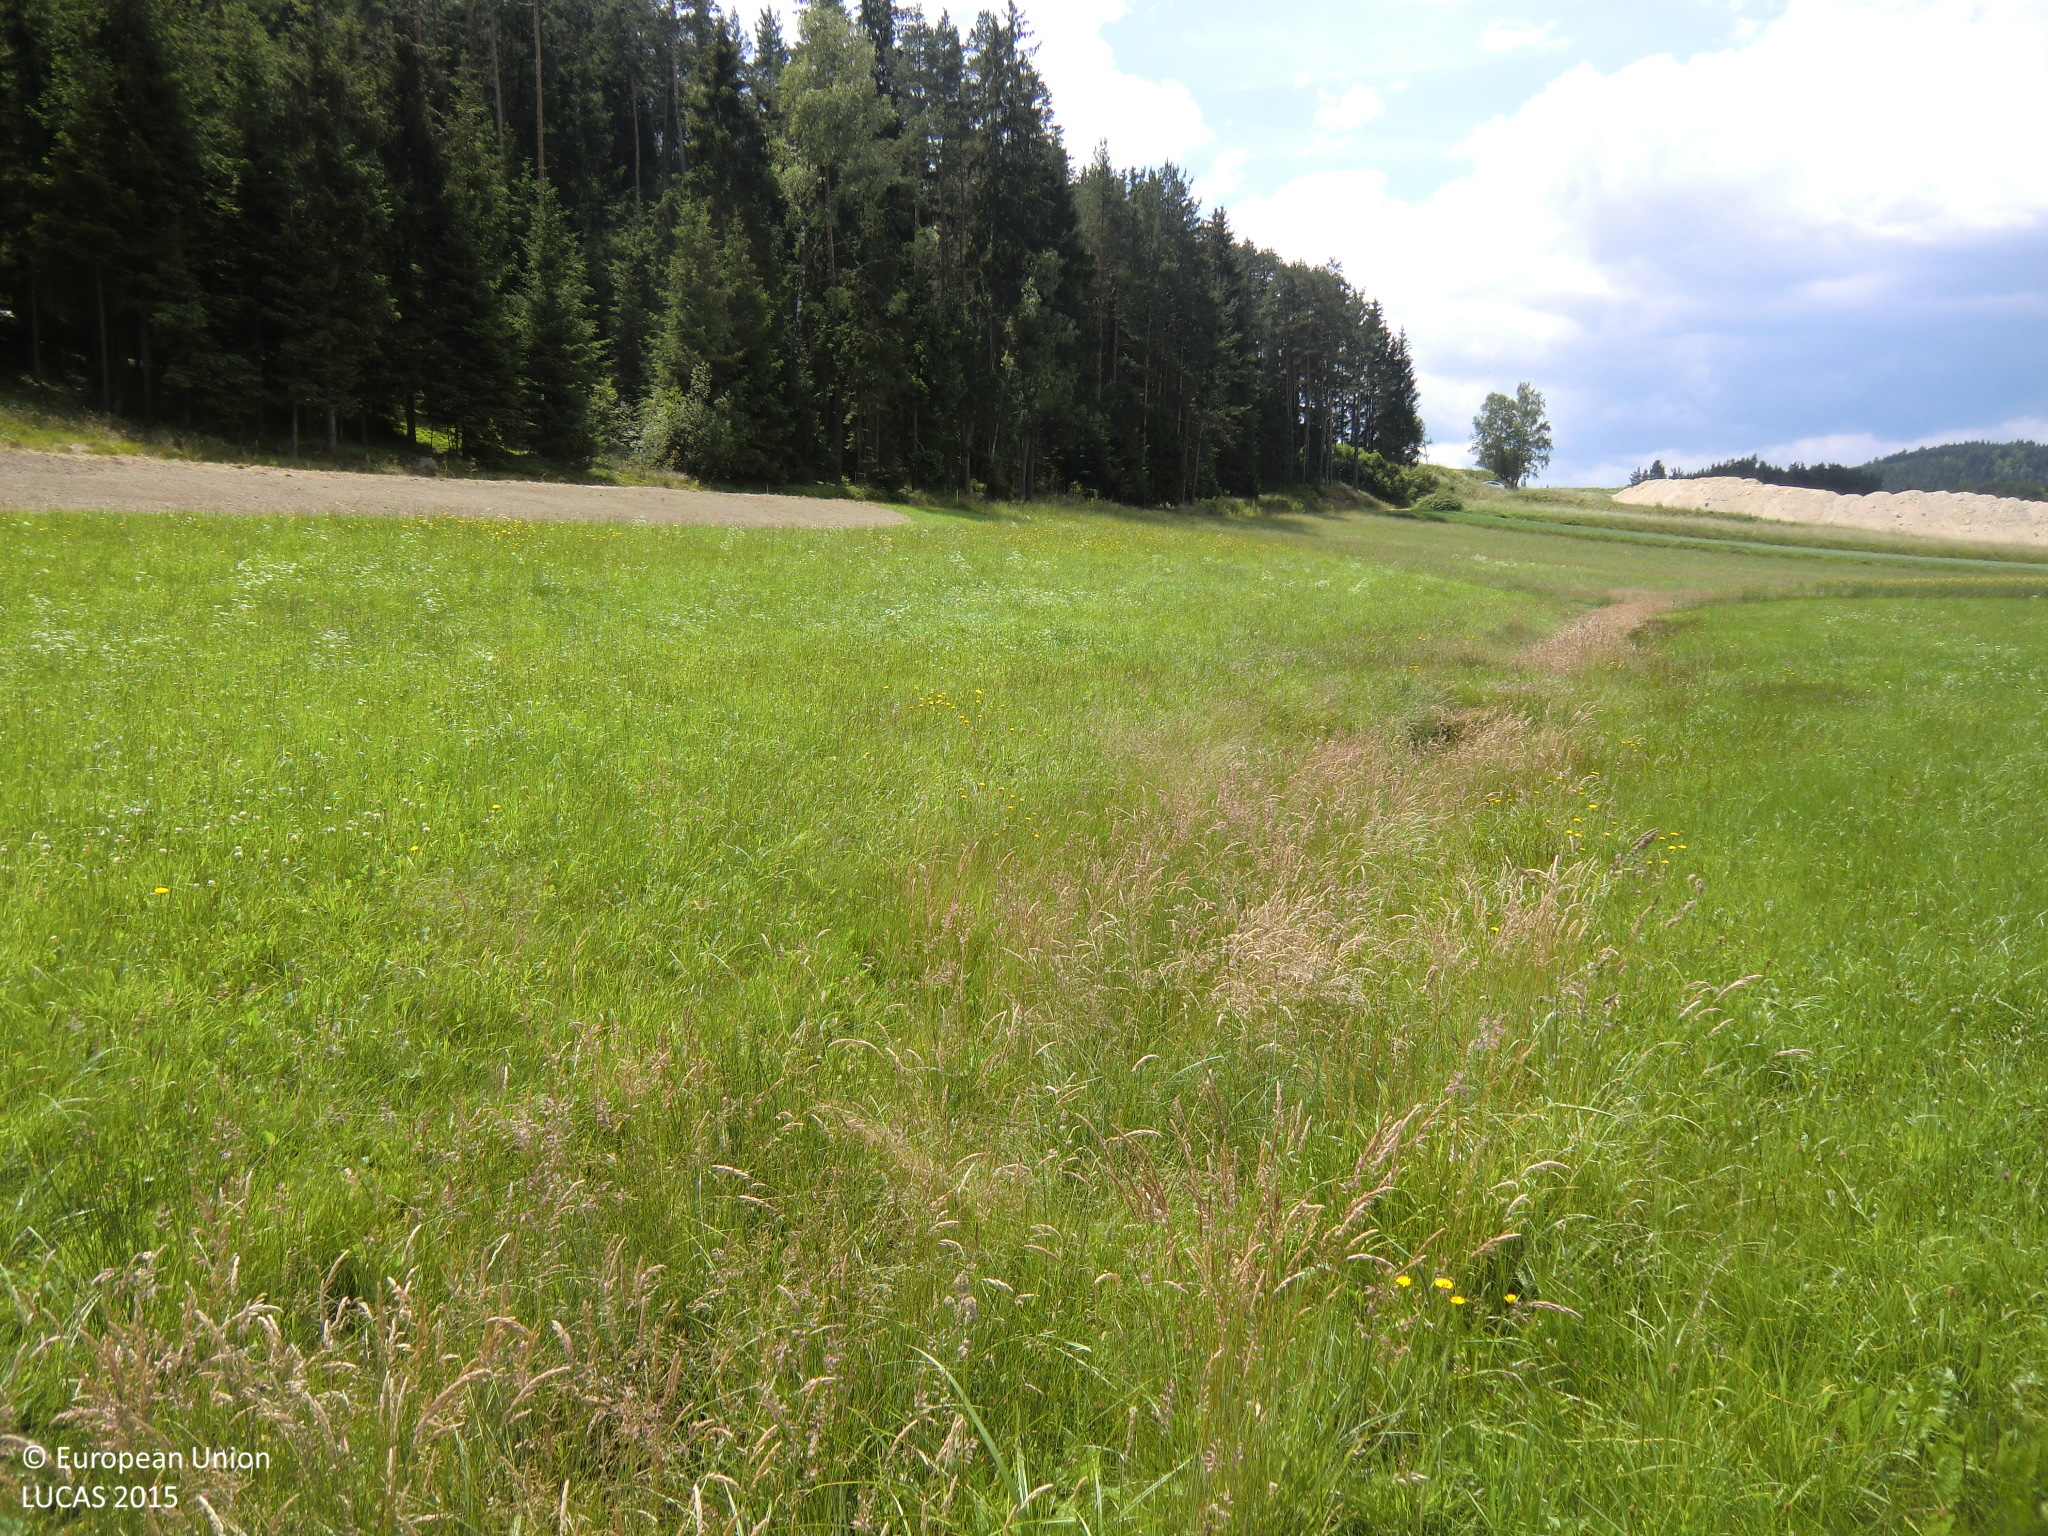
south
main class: Grassland
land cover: Grassland without tree/shrub cover
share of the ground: > 75 %
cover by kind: herbaceous plants 100 %
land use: Agriculture (excluding fallow land and kitchen gardens)
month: June
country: AT
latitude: 48.4865
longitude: 15.0484
